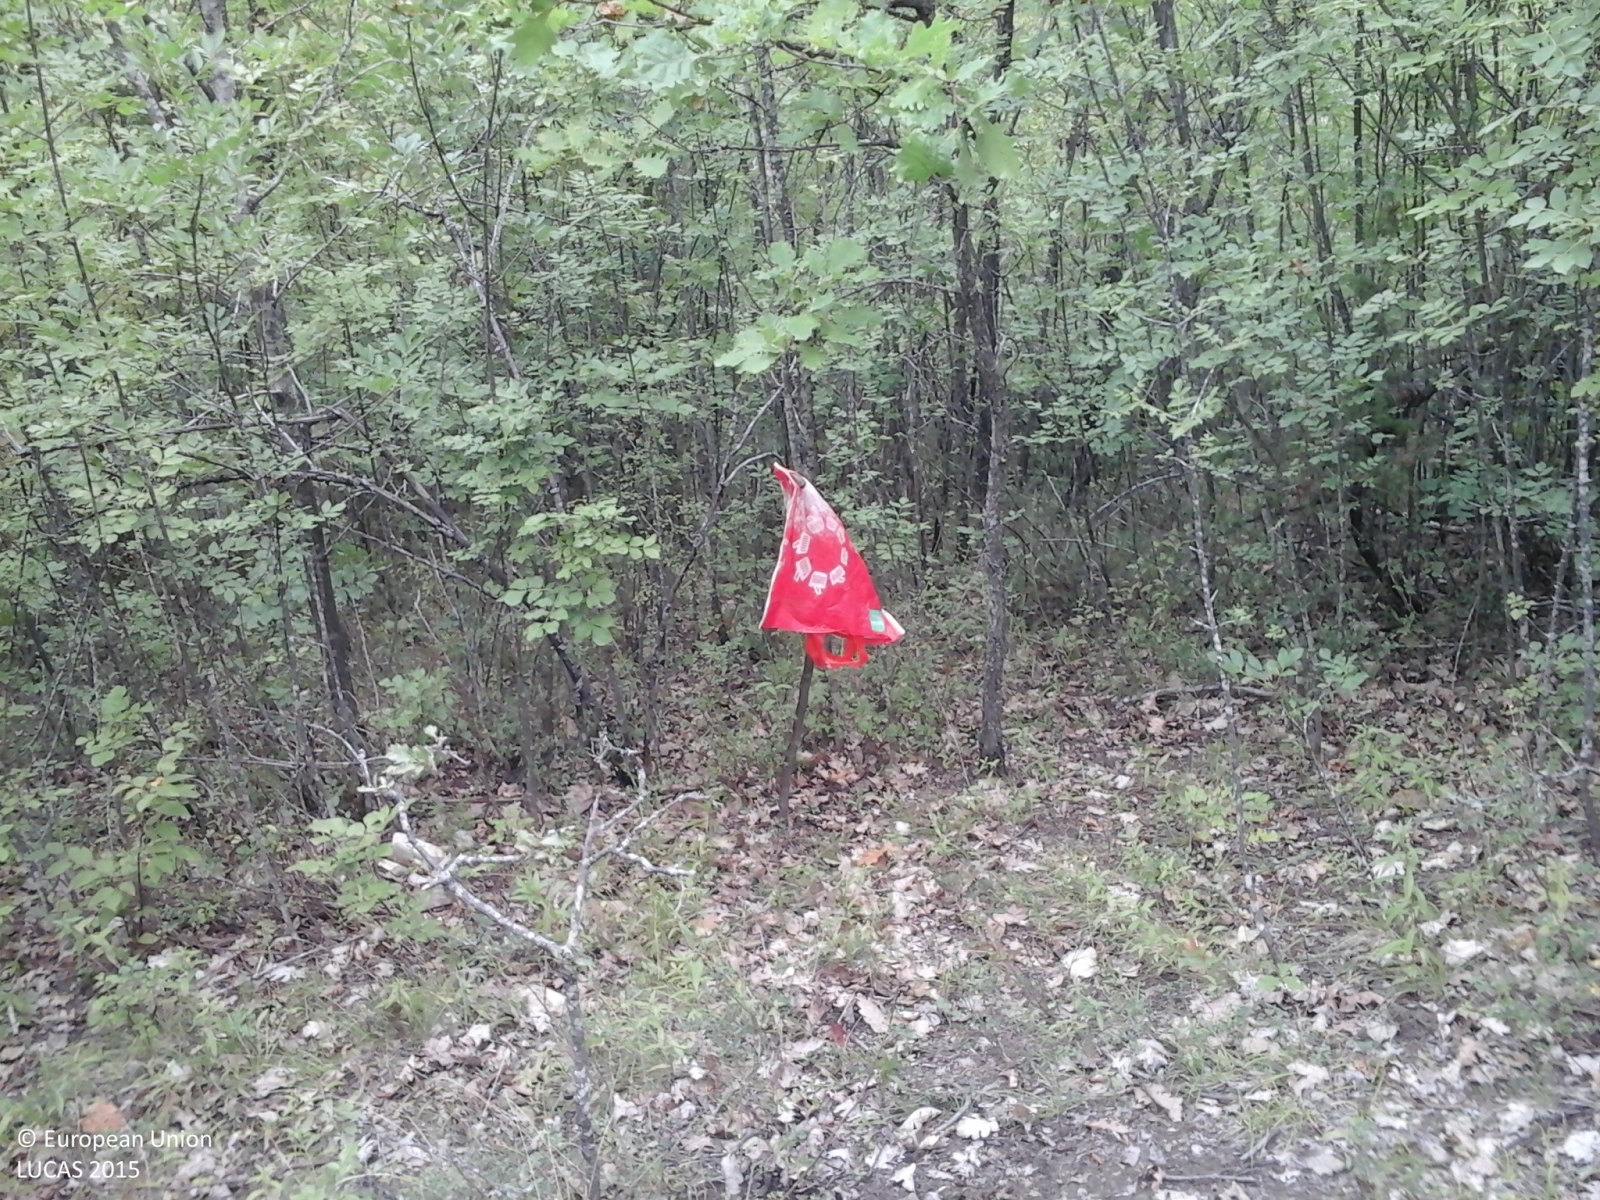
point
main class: Woodland
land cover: Broadleaved woodland
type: thermophilous deciduous forest
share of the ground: > 75 %
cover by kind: broadleaved forest trees 95 %, unconsolidated bare surface 5 %
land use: Forestry
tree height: < 5 m
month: August
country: IT
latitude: 44.8162
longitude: 9.1797
